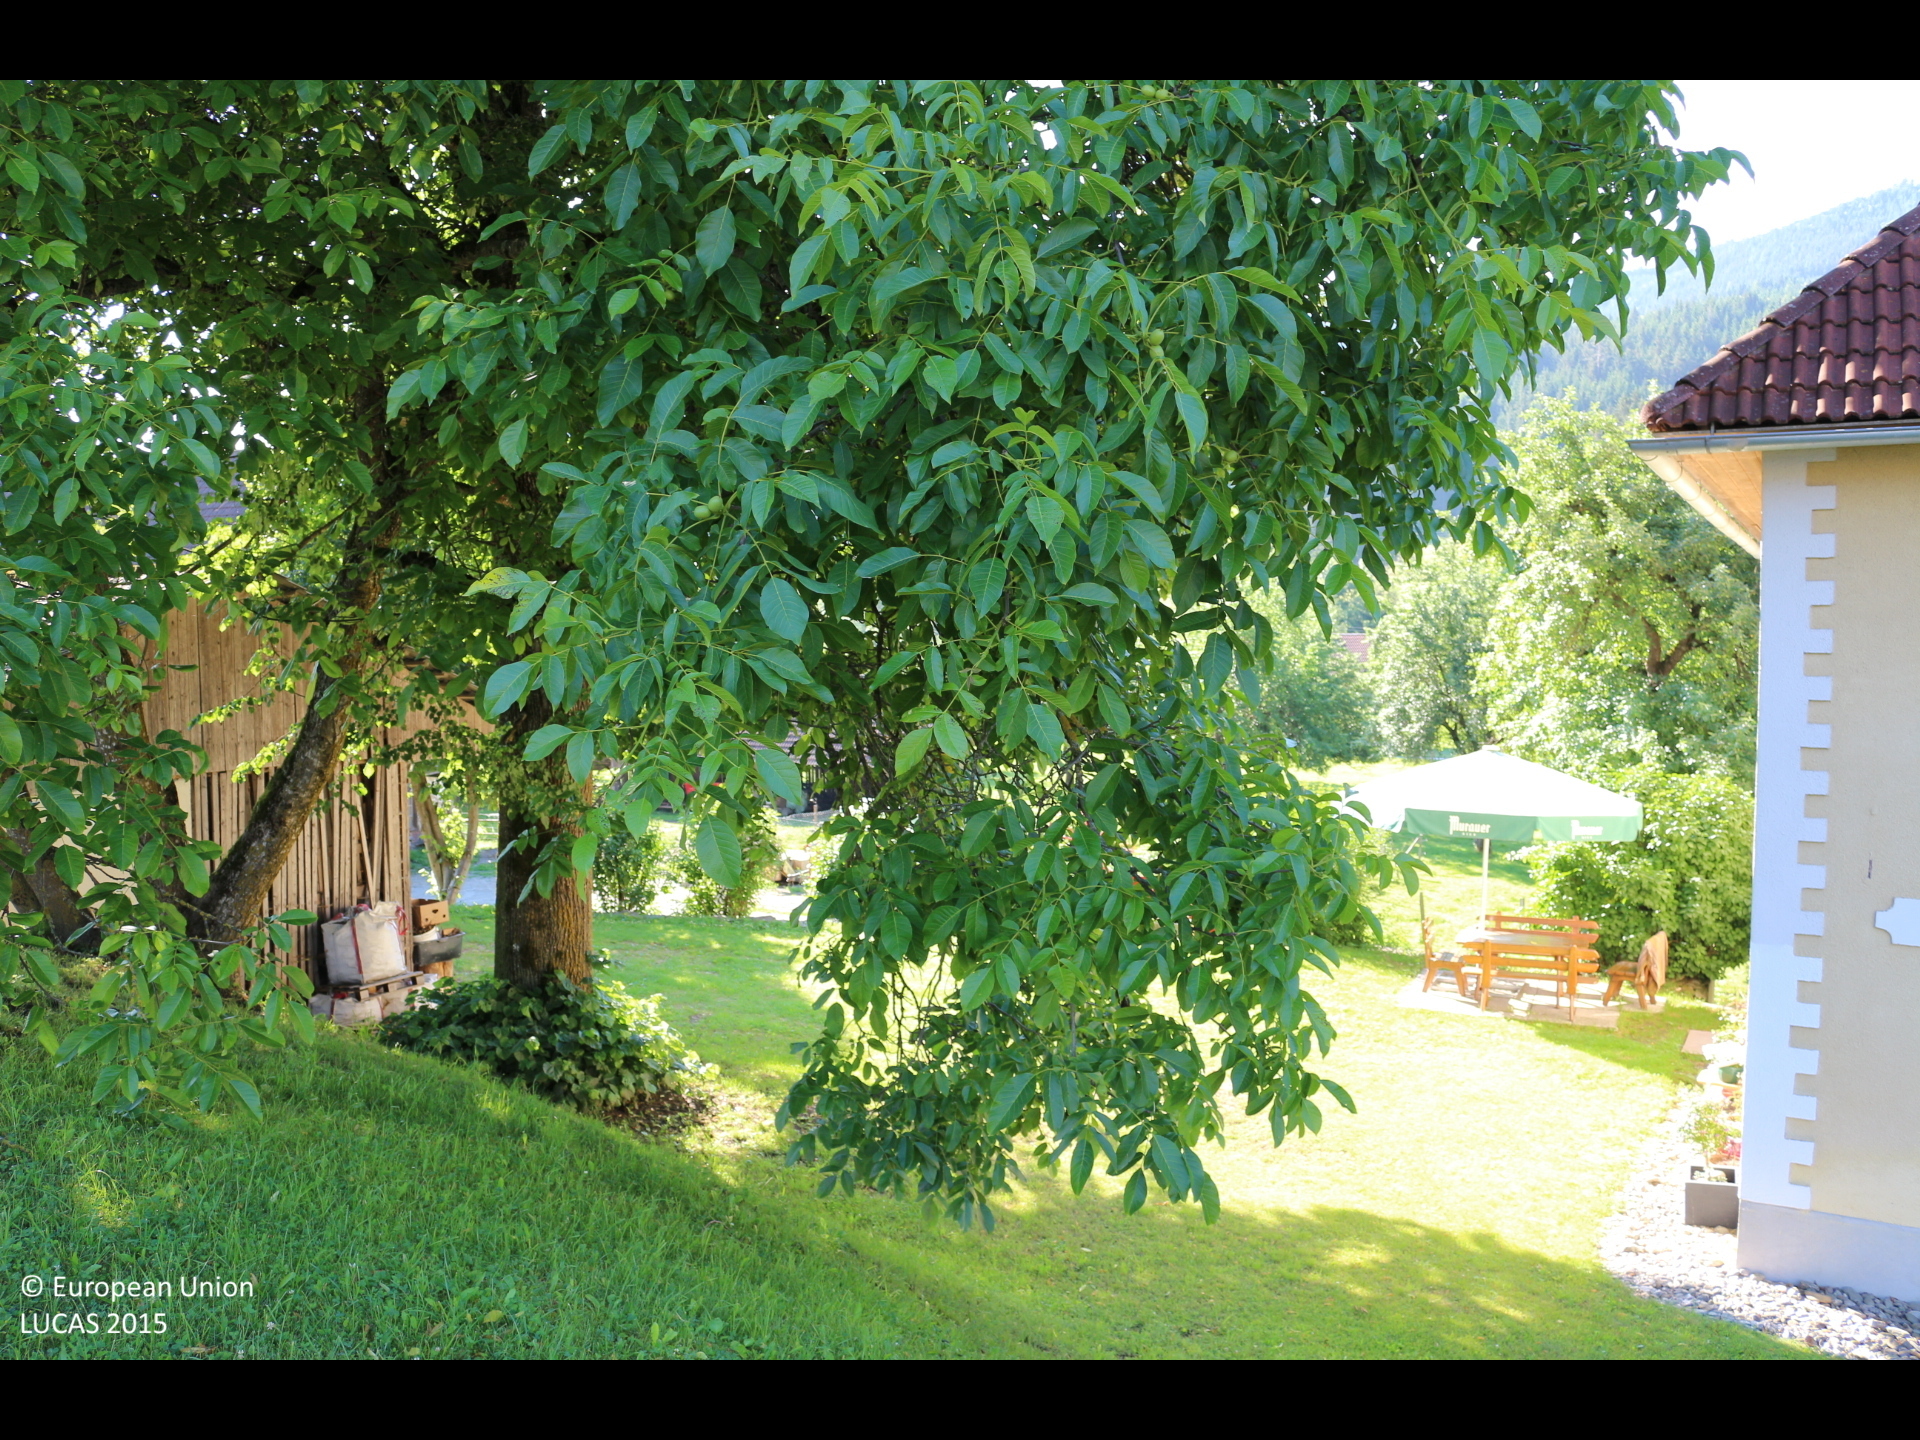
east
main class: Grassland
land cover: Grassland with sparse tree/shrub cover
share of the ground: > 75 %
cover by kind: herbaceous plants 95 %, broadleaved forest trees 5 %
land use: Agriculture (excluding fallow land and kitchen gardens)
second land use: Residential
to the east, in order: Grassland with sparse tree/shrub cover; Artificial constructions in urban areas; Fences; Grassland with sparse tree/shrub cover; Grassland without tree/shrub cover; Fences; Grassland without tree/shrub cover
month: June
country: AT
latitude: 46.8625
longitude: 14.2348
